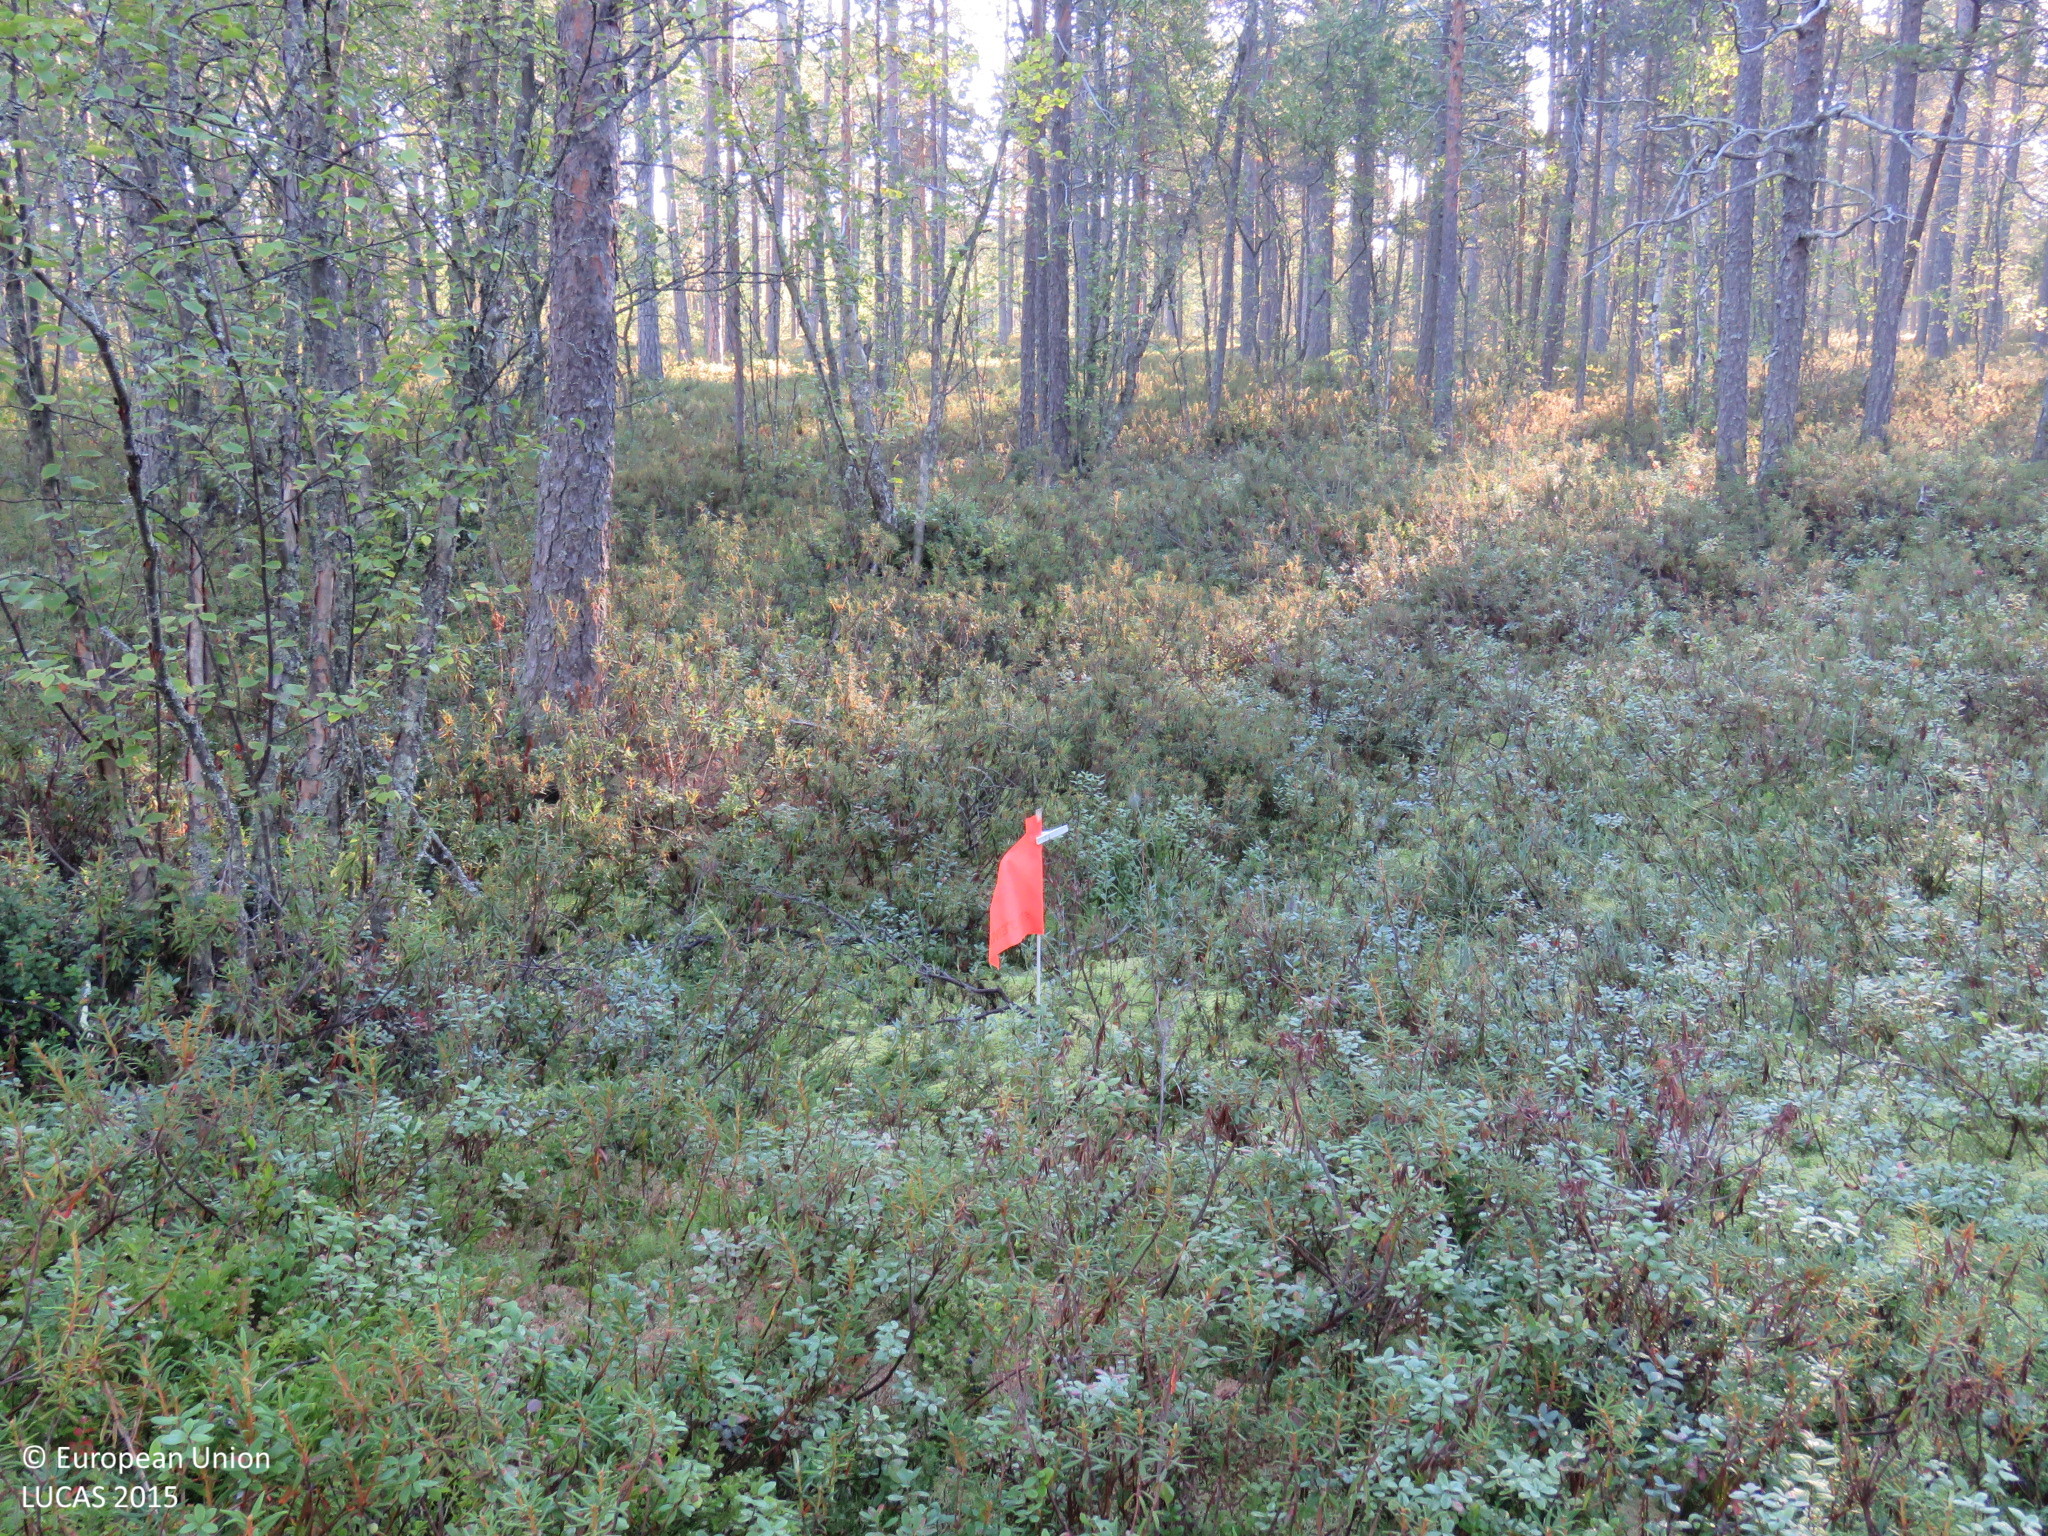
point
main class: Woodland
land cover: Pine dominated coniferous woodland
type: boreal forest
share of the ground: > 75 %
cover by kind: coniferous forest trees 60 %, shrubs 20 %, broadleaved forest trees 15 %, lichens and mosses 5 %
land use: Forestry
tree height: > 5 m
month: August
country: FI
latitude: 65.0055
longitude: 24.6379
